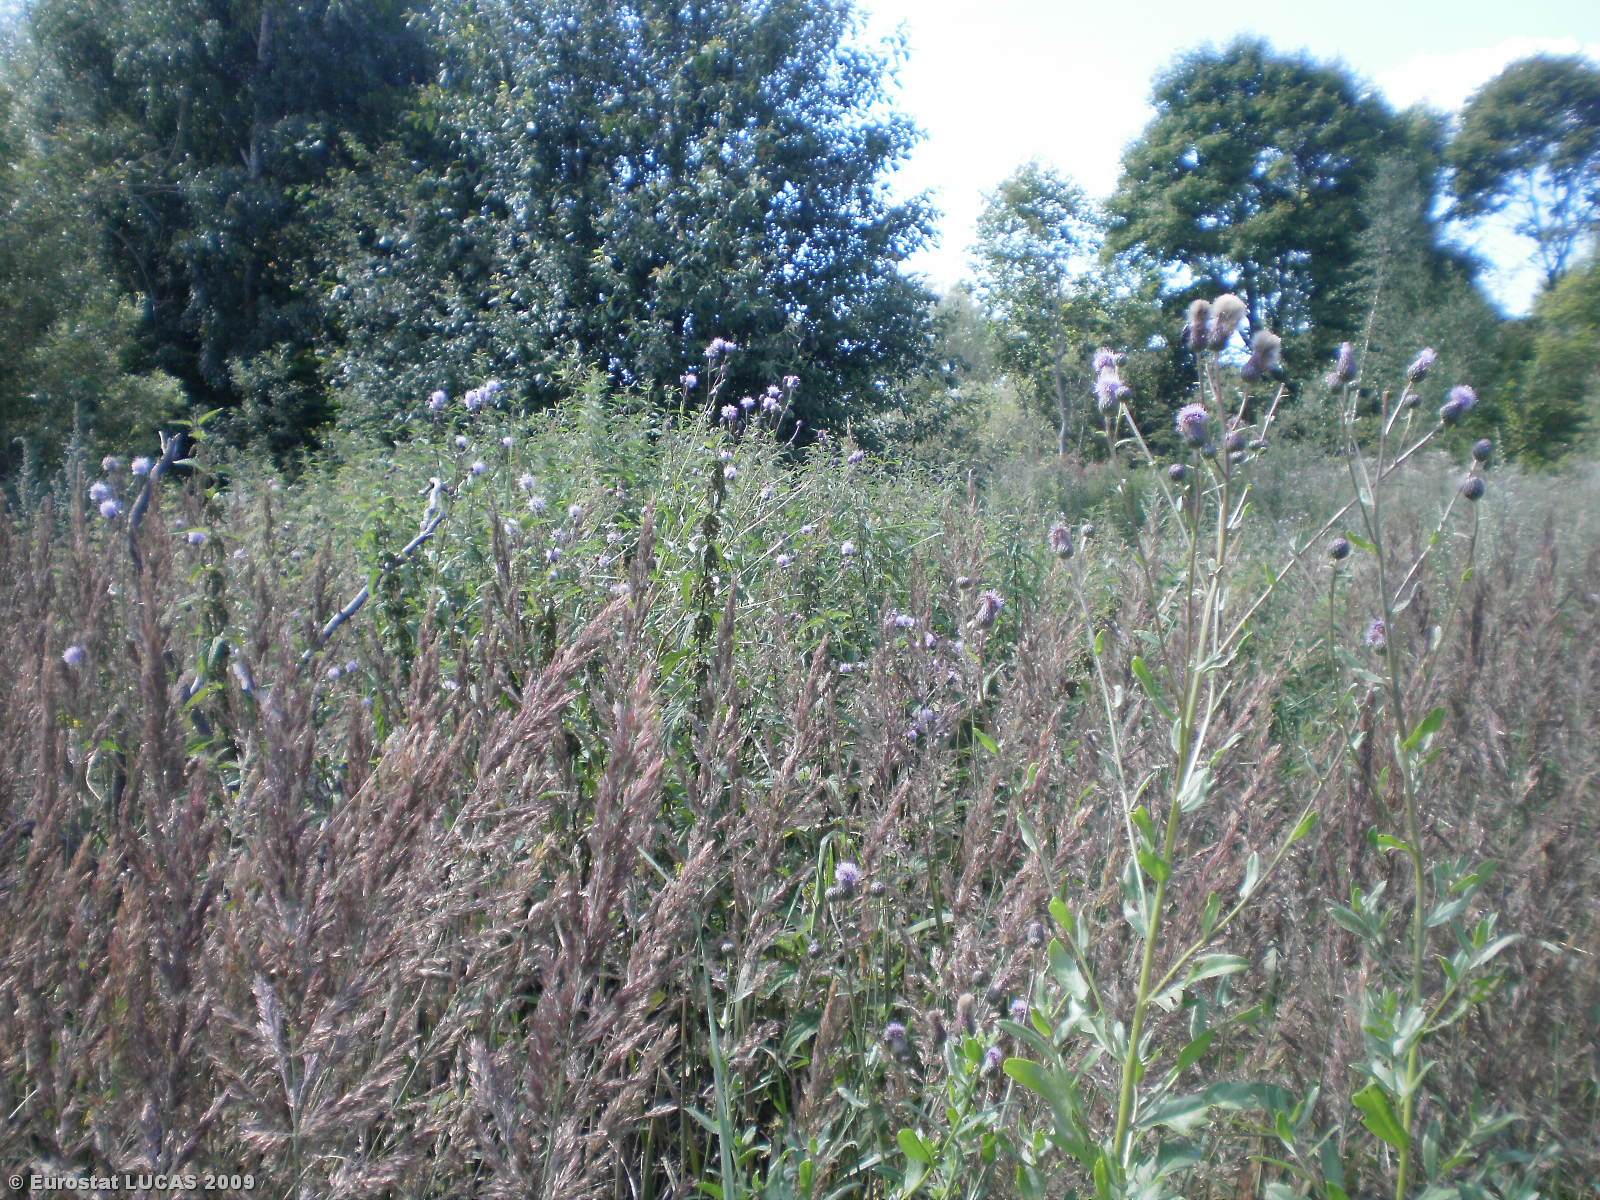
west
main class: Grassland
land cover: Grassland with sparse tree/shrub cover
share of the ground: > 75 %
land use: Unused
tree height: < 5 m
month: August
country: LT
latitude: 55.6156
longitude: 24.9556
